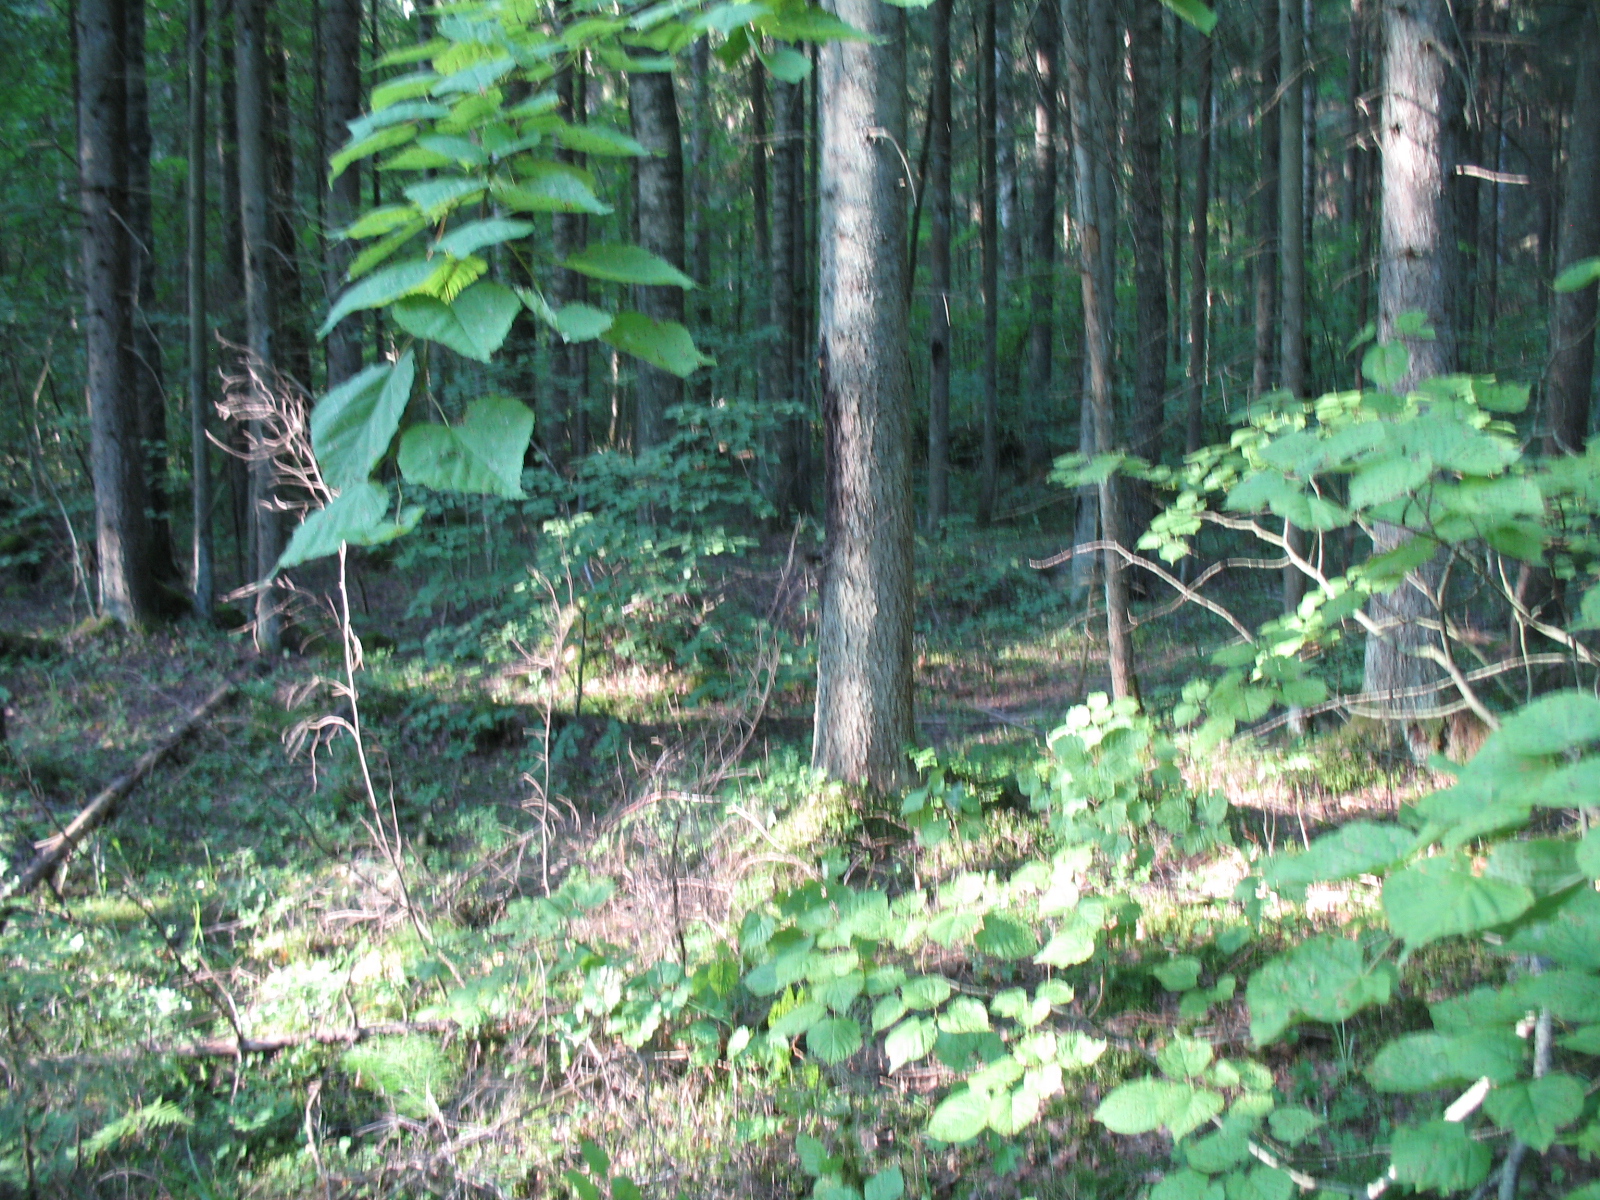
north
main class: Woodland
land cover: Spruce dominated mixed woodland
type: hemiboreal forest and nemoral coniferous forest and mixed broadleaved-coniferous forest
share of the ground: > 75 %
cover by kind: coniferous forest trees 50 %, broadleaved forest trees 35 %, lichens and mosses 10 %, herbaceous plants 5 %
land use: Forestry
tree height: > 5 m
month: August
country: LV
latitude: 56.4021
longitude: 25.4312
